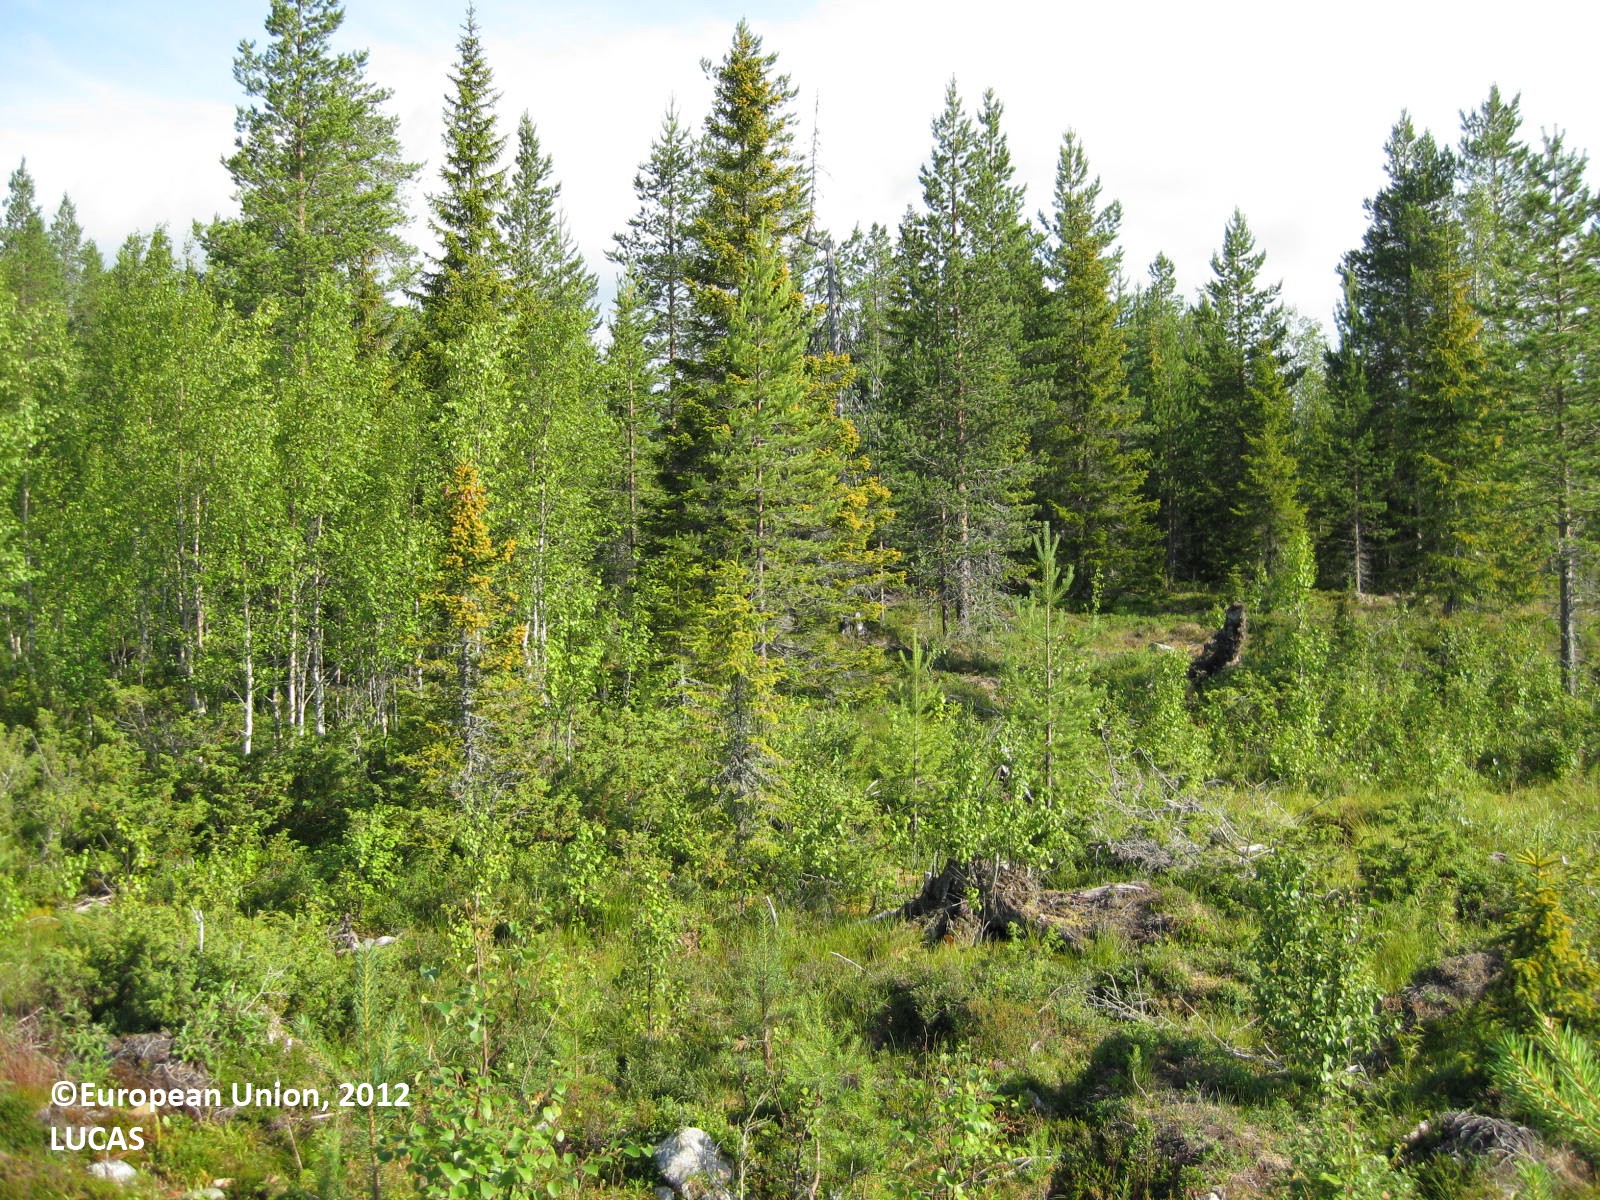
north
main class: Woodland
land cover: Pine dominated mixed woodland
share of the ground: 25 - 50 %
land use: Forestry
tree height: < 5 m
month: July
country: FI
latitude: 65.8293
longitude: 28.5659
